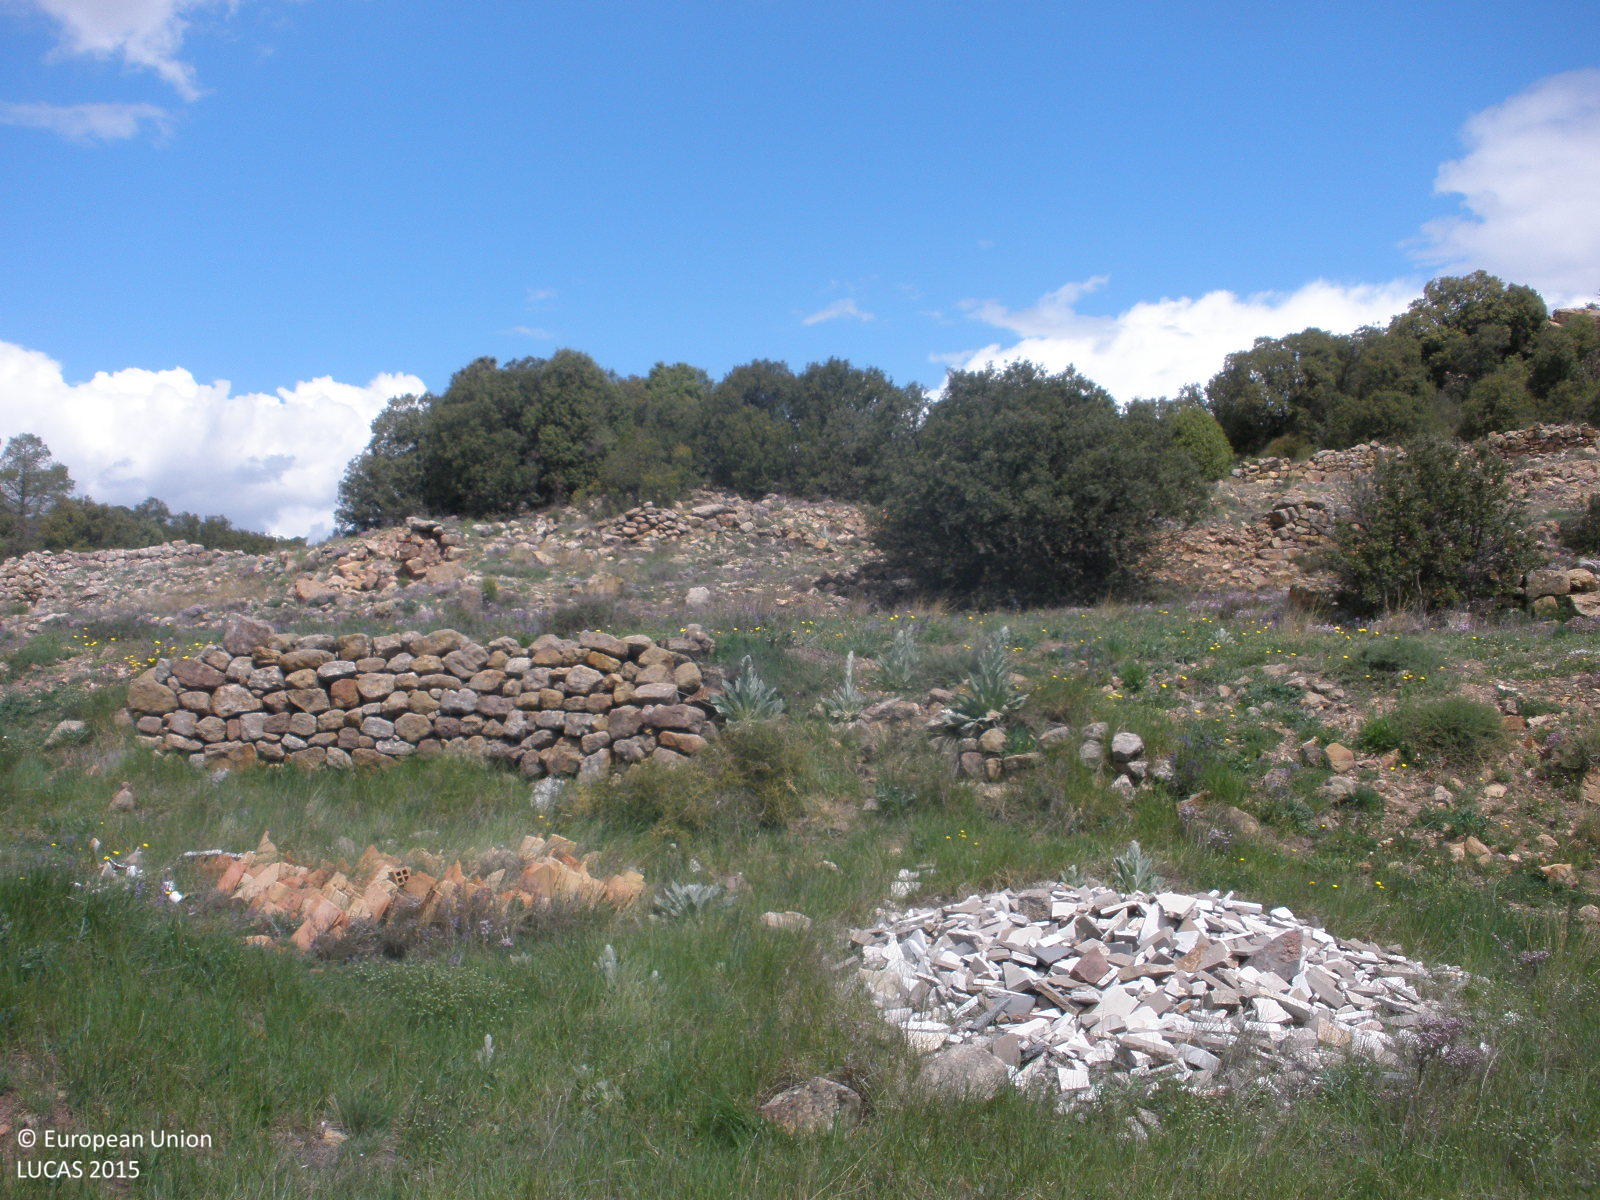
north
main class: Woodland
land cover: Broadleaved woodland
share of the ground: 10 - 25 %
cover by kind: herbaceous plants 70 %, broadleaved forest trees 20 %, consolidated bare surface 10 %
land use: Semi-natural and natural areas not in use
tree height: < 5 m
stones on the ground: < 10 %
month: April
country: ES
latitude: 40.2388
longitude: -0.7625
